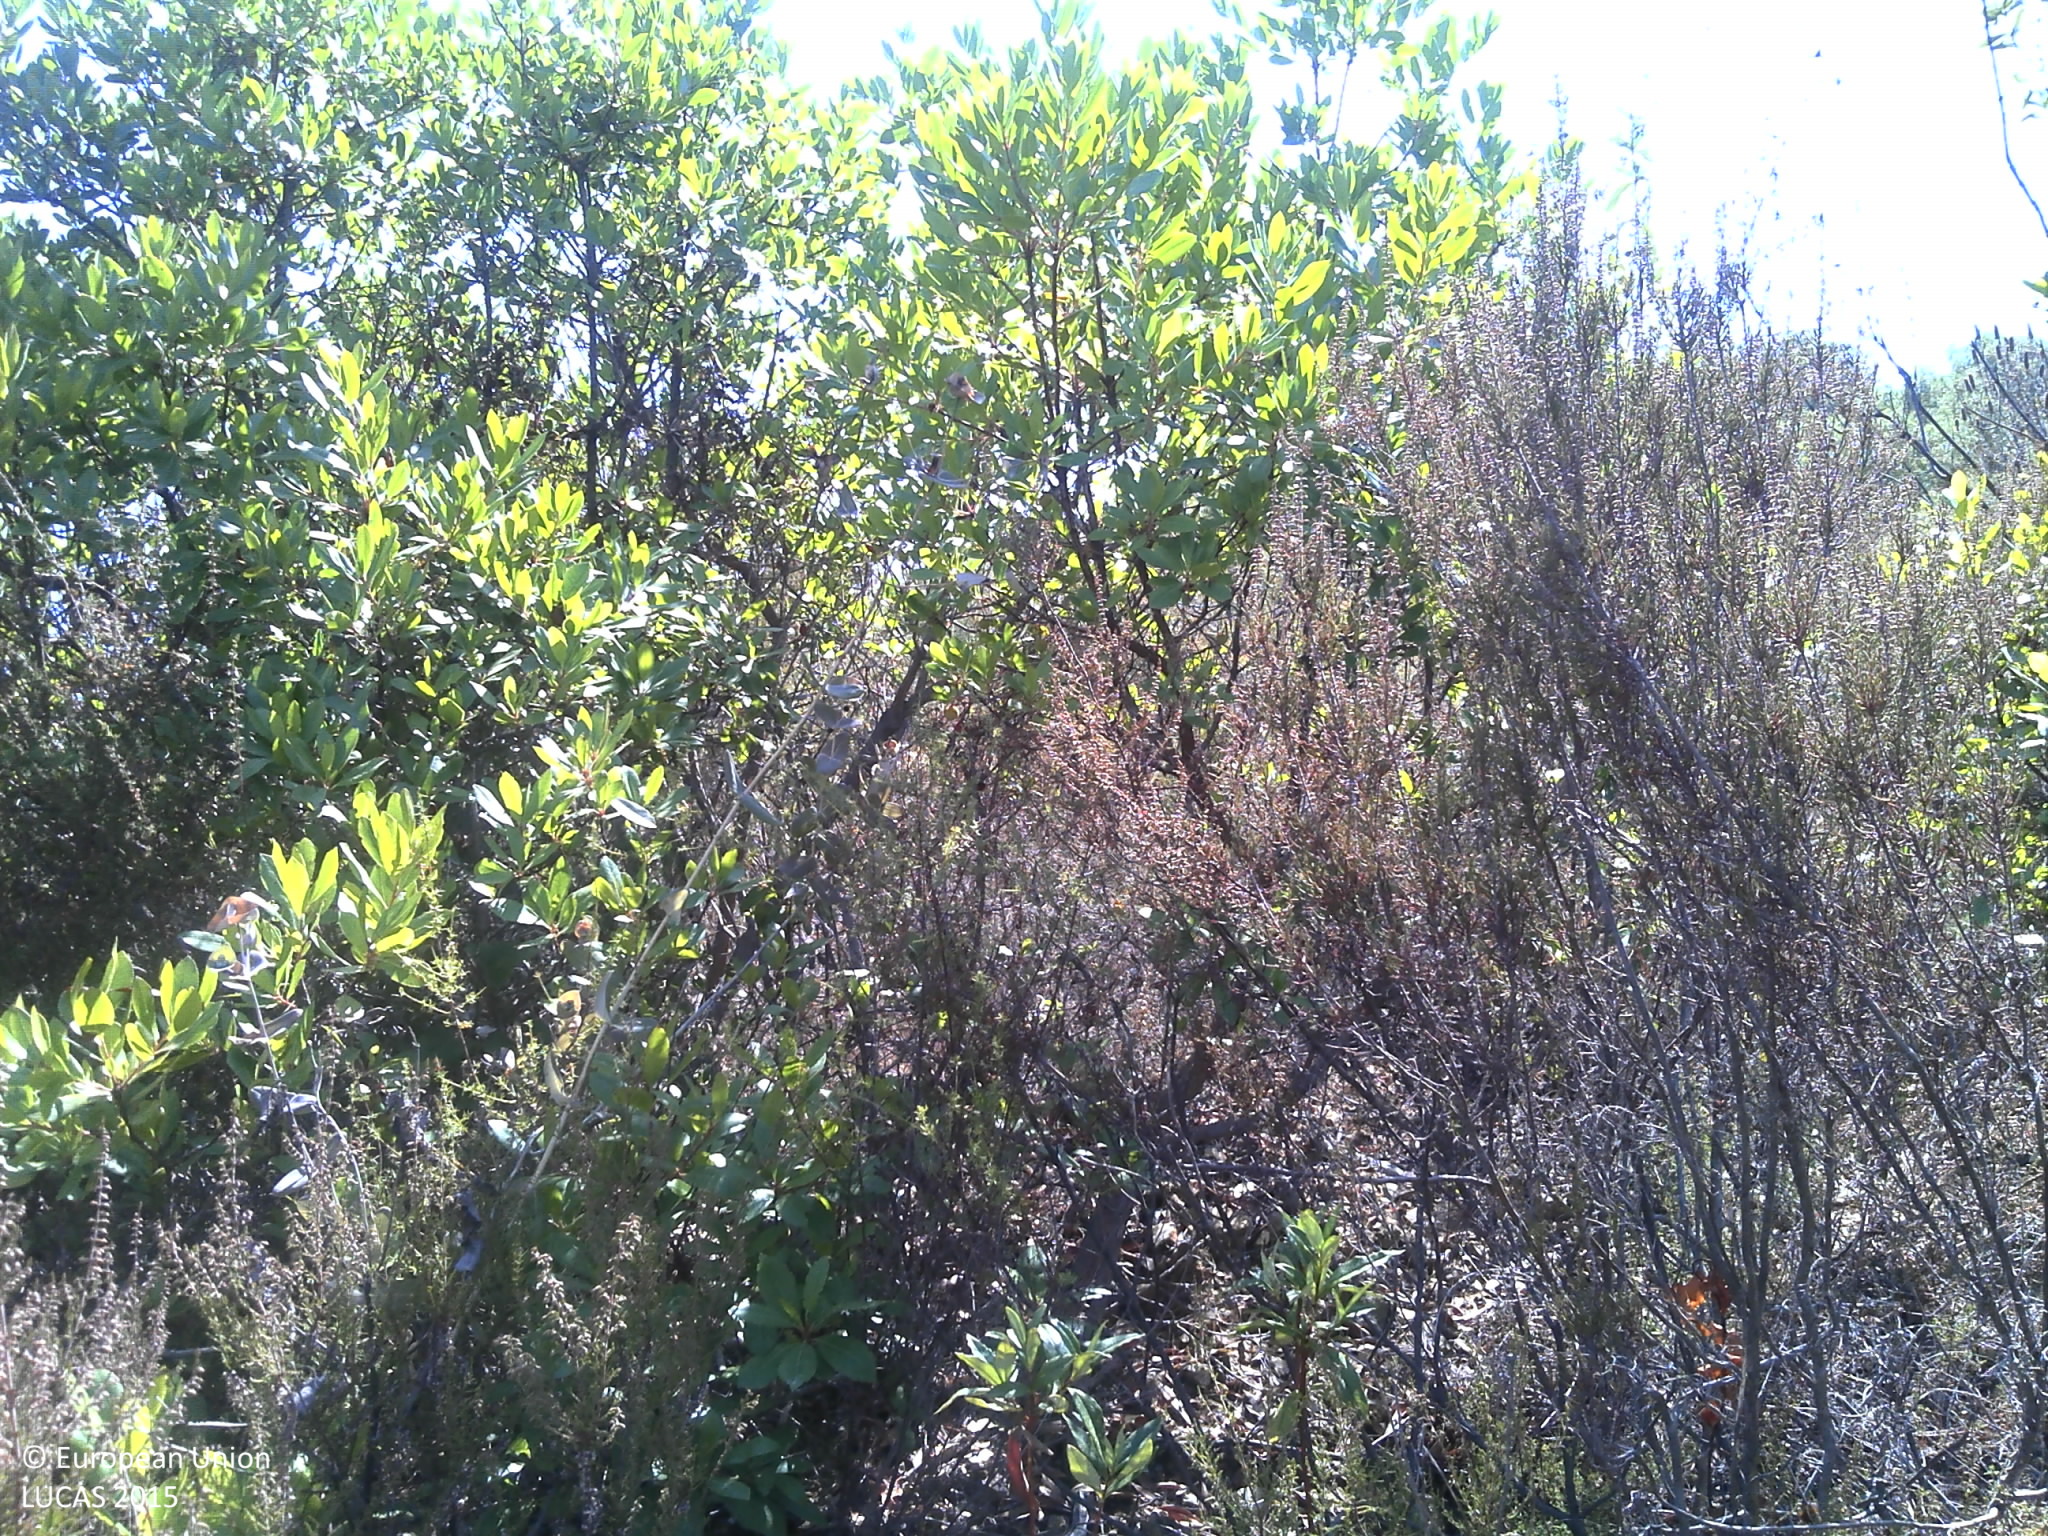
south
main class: Shrubland
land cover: Shrubland with sparse tree cover
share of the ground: 50 - 75 %
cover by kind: shrubs 70 %, unconsolidated bare surface 25 %, broadleaved forest trees 5 %
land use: Abandoned areas
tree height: < 5 m
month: September
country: PT
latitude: 37.4016
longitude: -8.1994
